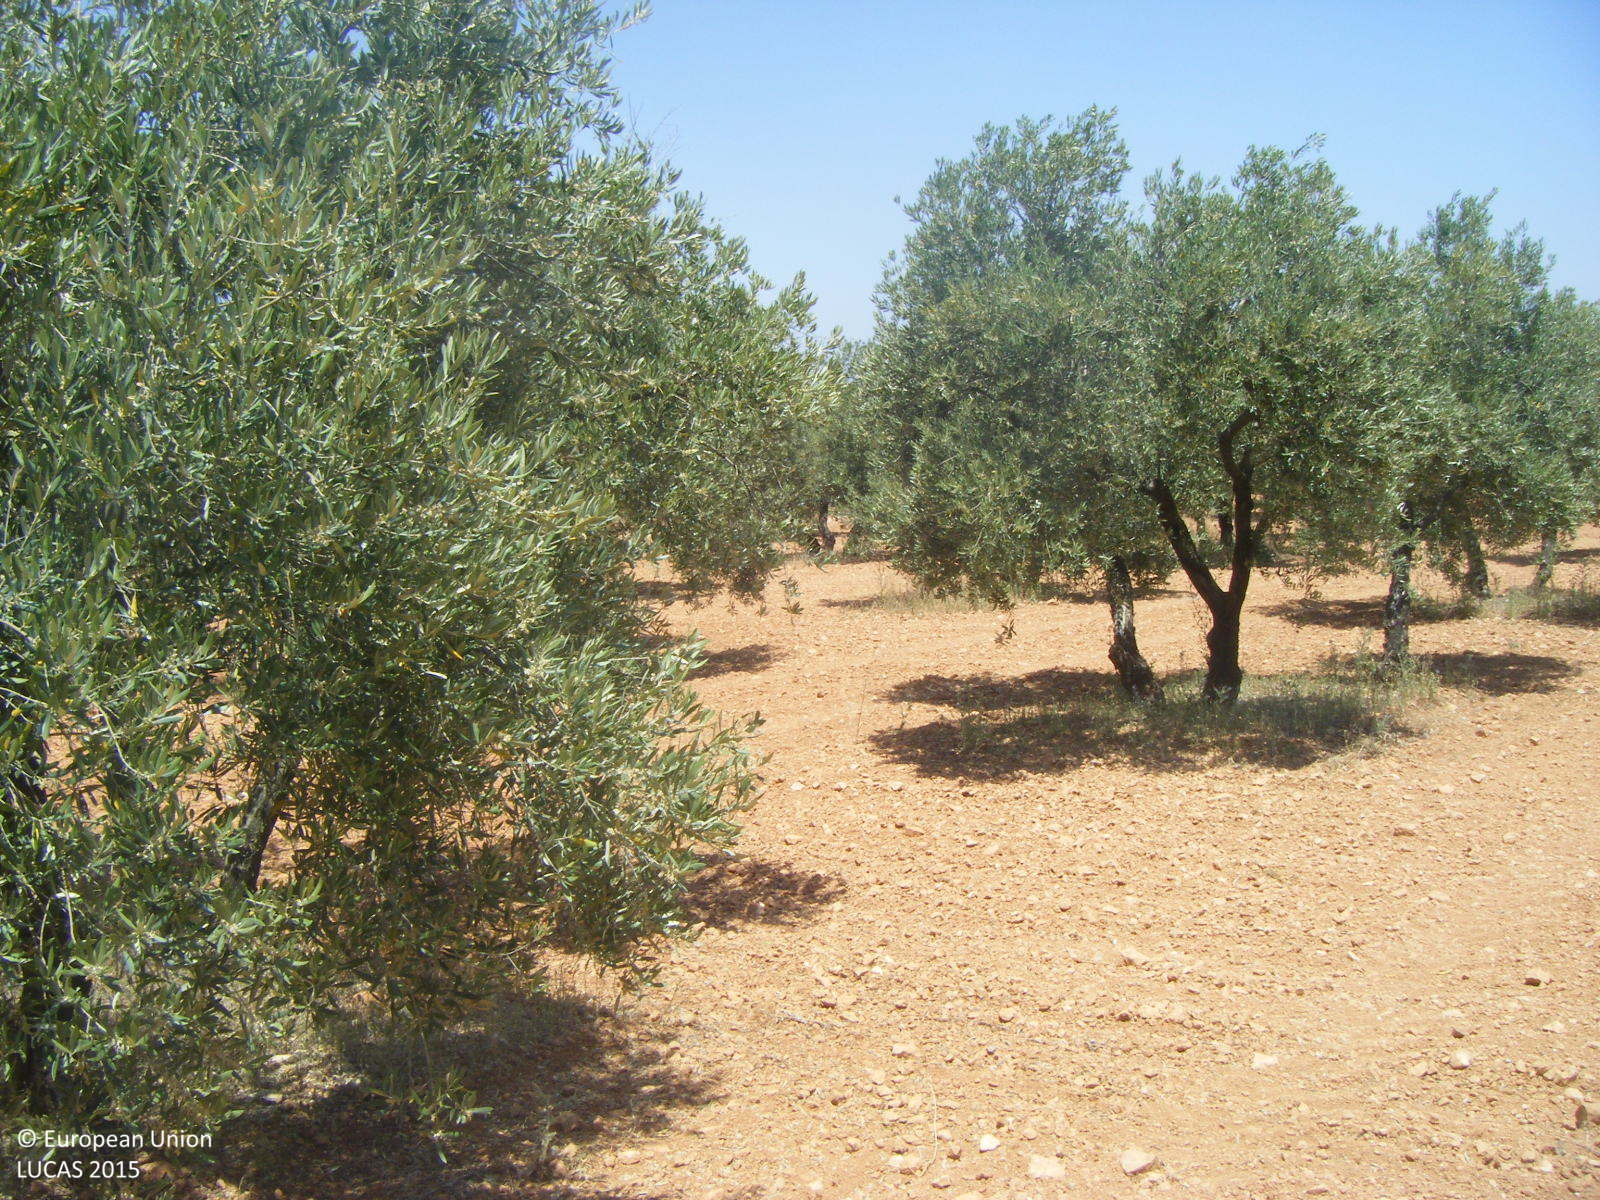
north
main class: Cropland
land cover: Olive groves
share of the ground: 25 - 50 %
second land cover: Other bare soil
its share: > 75 %
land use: Agriculture (excluding fallow land and kitchen gardens)
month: May
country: ES
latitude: 37.2653
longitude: -4.7871
